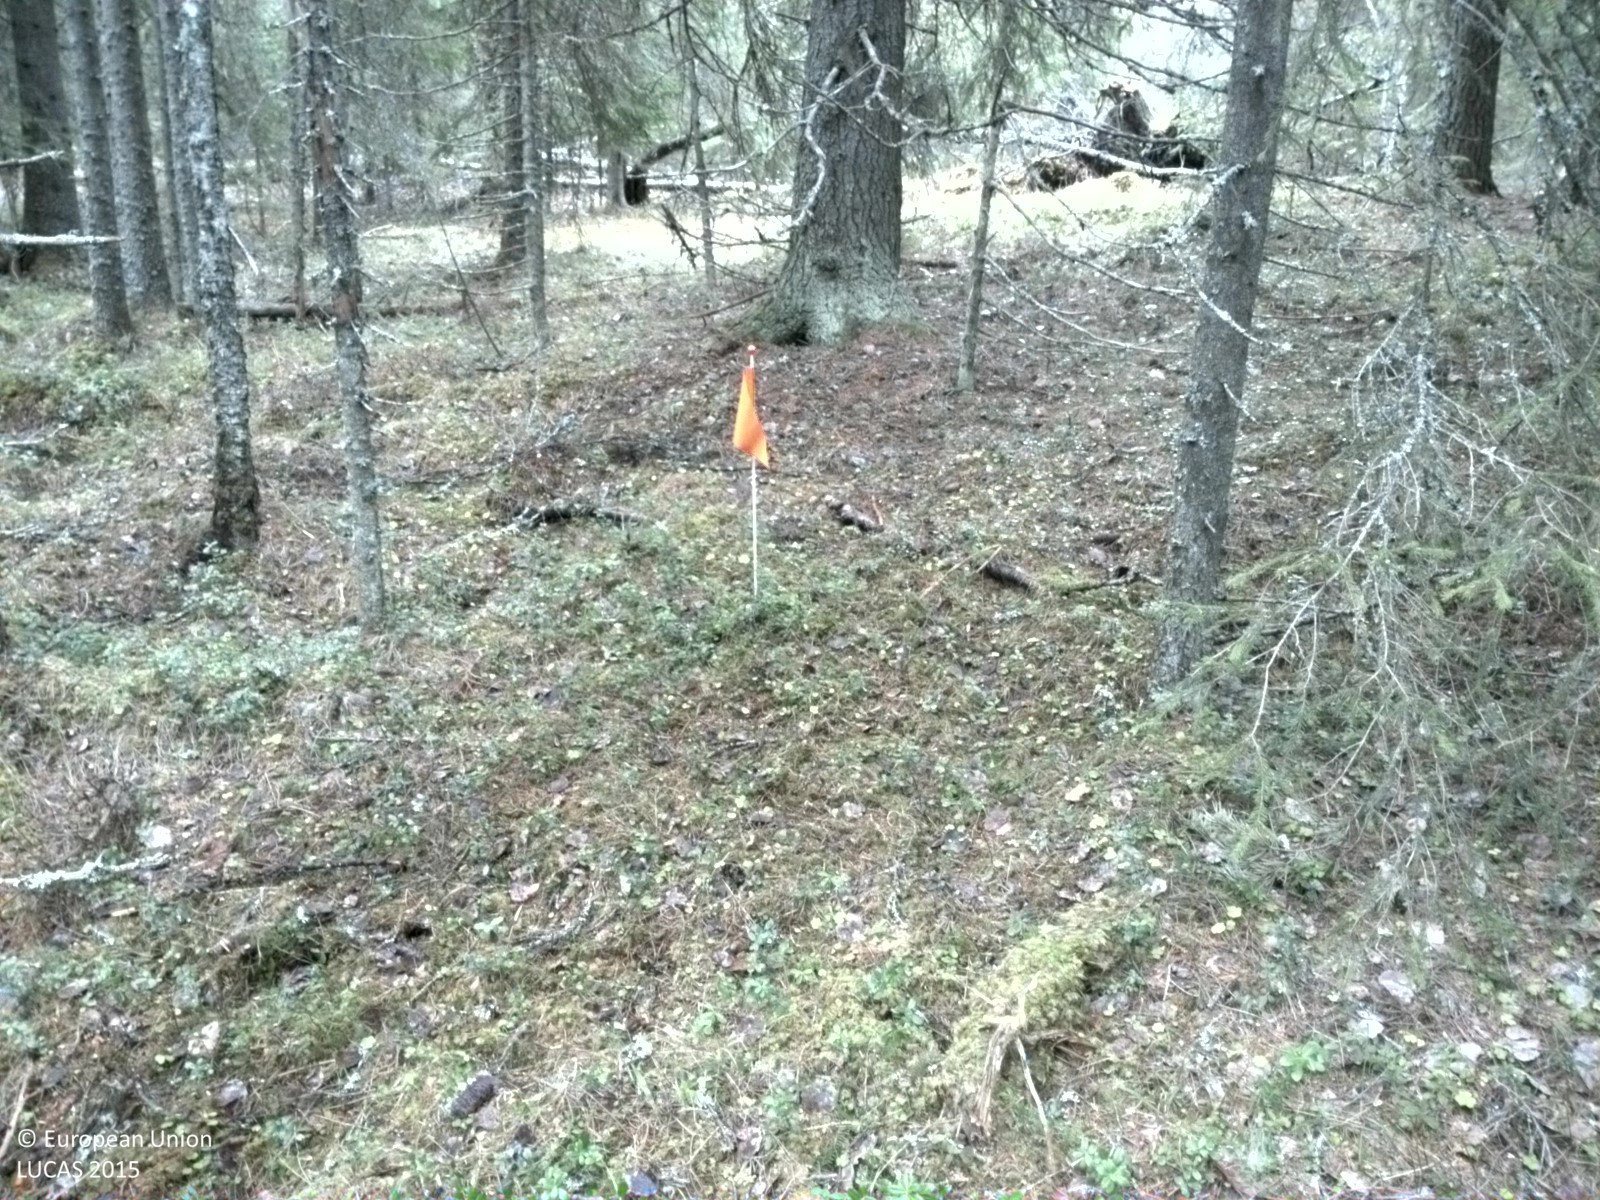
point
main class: Woodland
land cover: Spruce dominated coniferous woodland
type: boreal forest
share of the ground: > 75 %
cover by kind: coniferous forest trees 90 %, shrubs 5 %, lichens and mosses 5 %
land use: Forestry
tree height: > 5 m
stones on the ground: 10 - 25 %
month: May
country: SE
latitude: 63.4308
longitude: 13.8081
